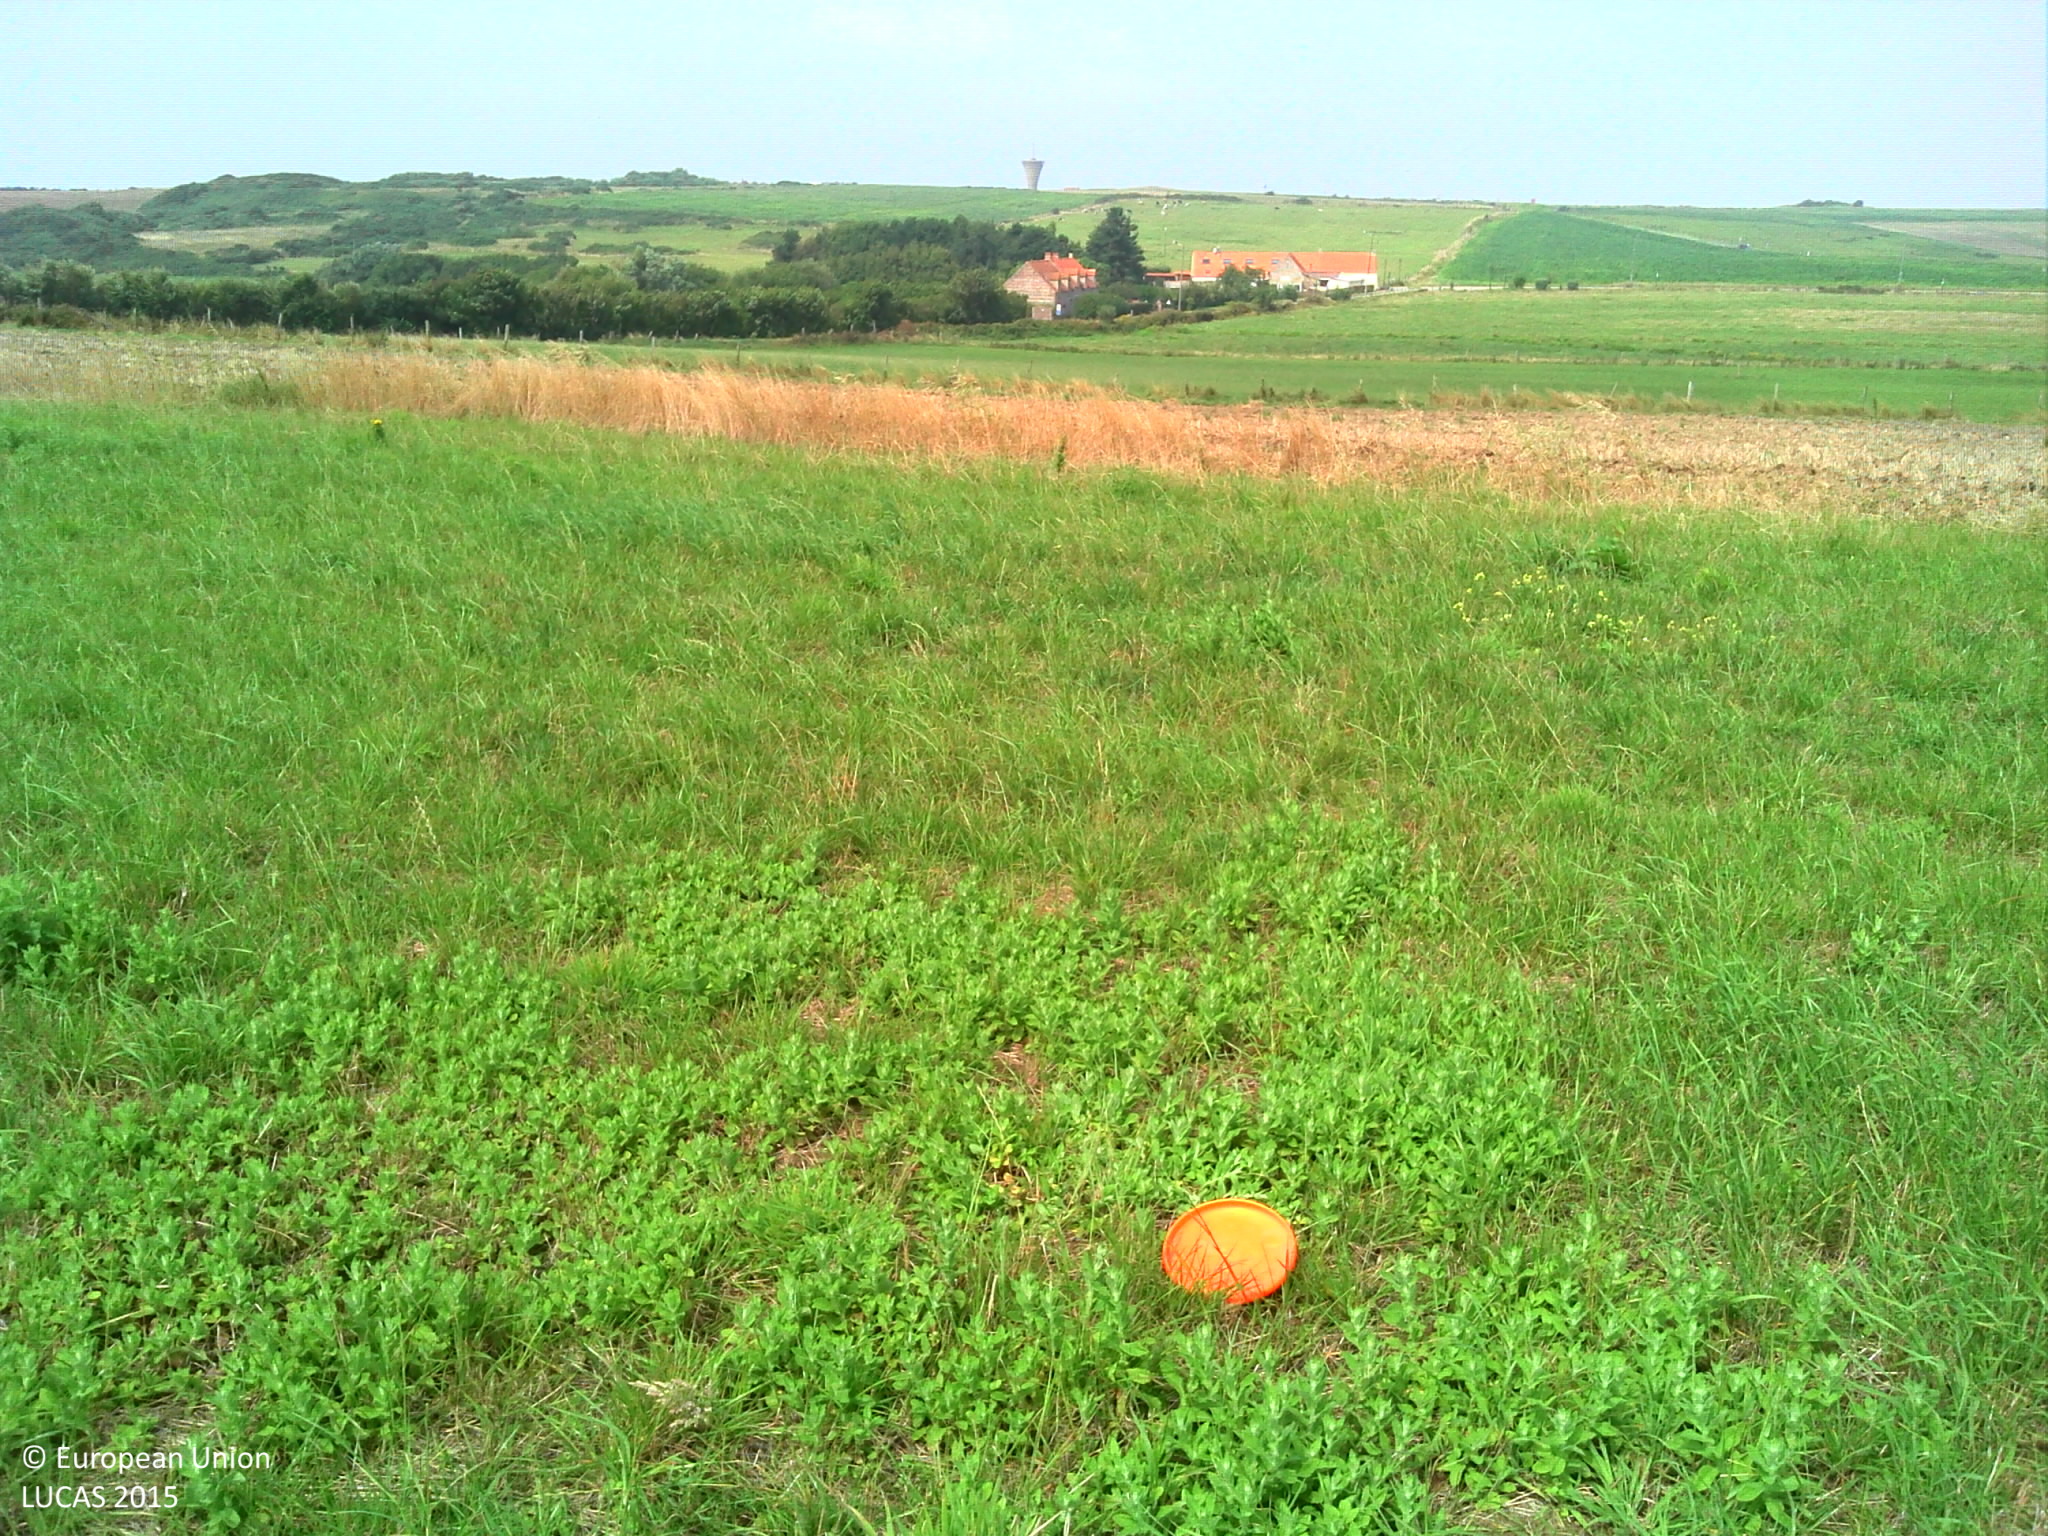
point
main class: Cropland
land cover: Temporary grasslands
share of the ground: > 75 %
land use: Agriculture (excluding fallow land and kitchen gardens)
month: August
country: FR
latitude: 50.6687
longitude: 1.5911
